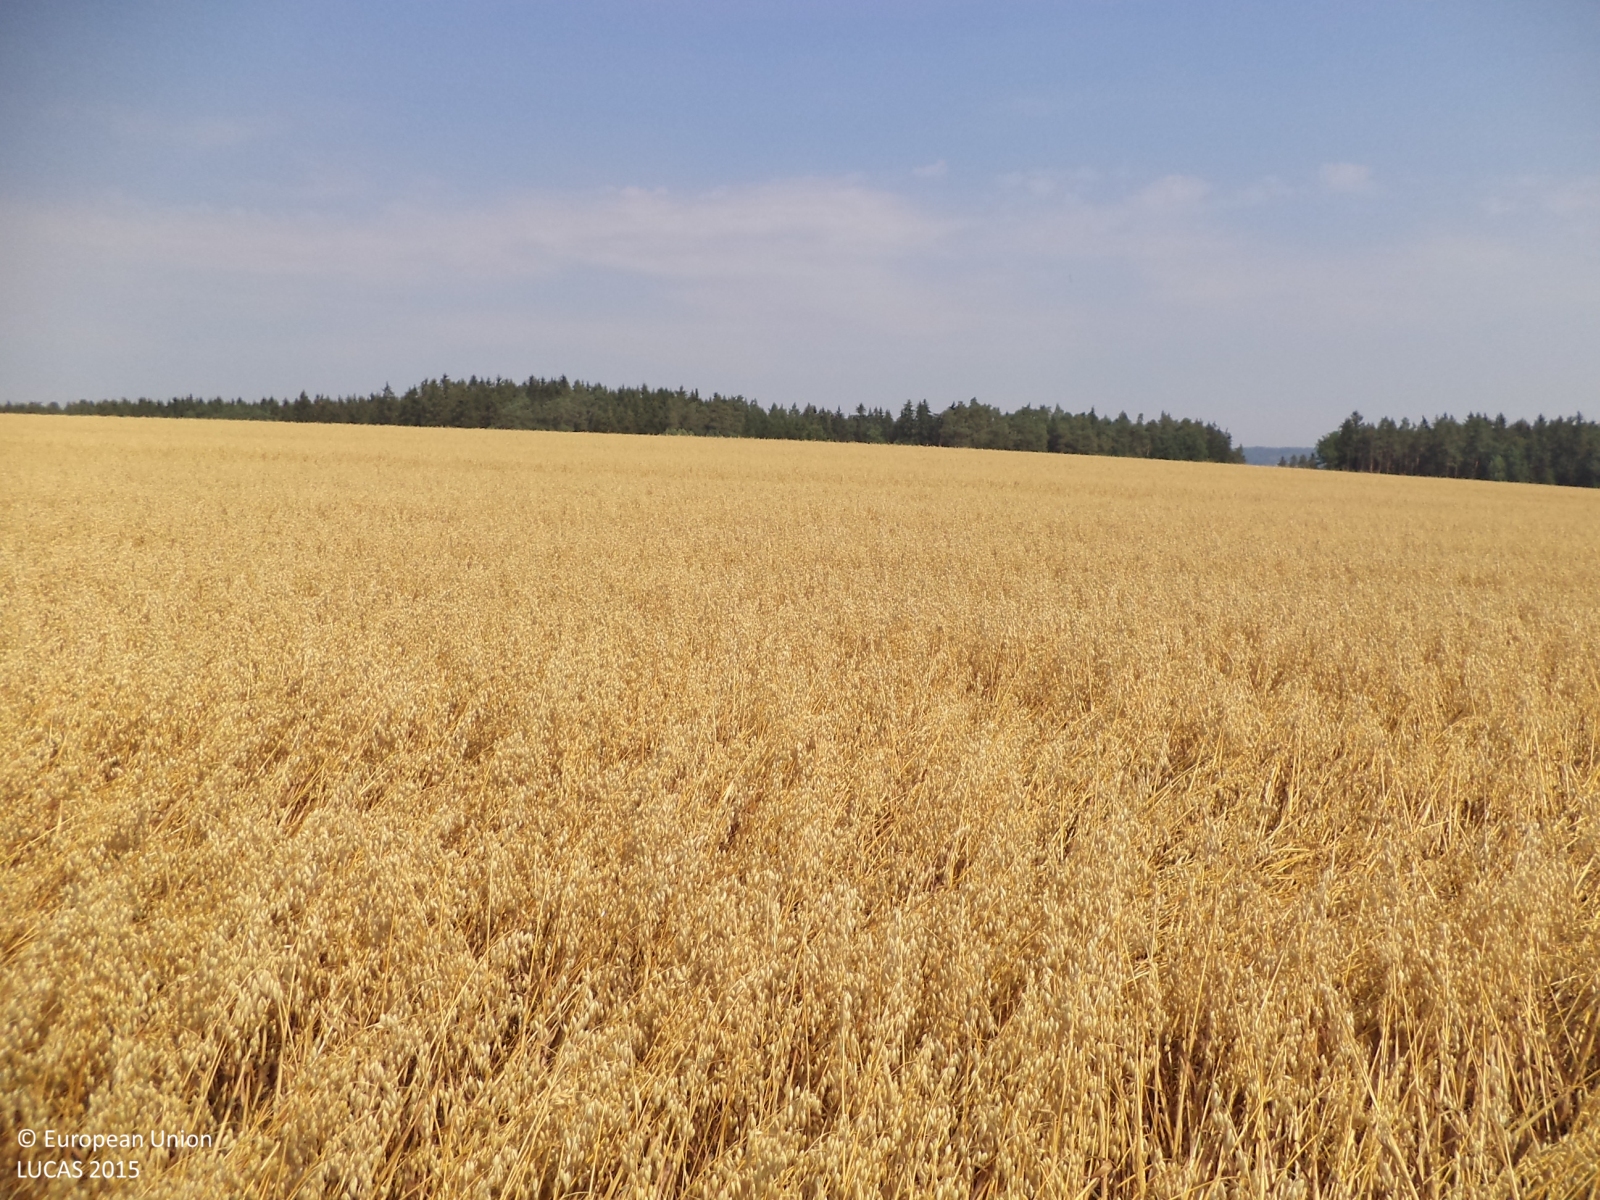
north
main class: Cropland
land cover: Oats
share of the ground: > 75 %
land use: Agriculture (excluding fallow land and kitchen gardens)
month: August
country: CZ
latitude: 49.4319
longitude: 14.4275
